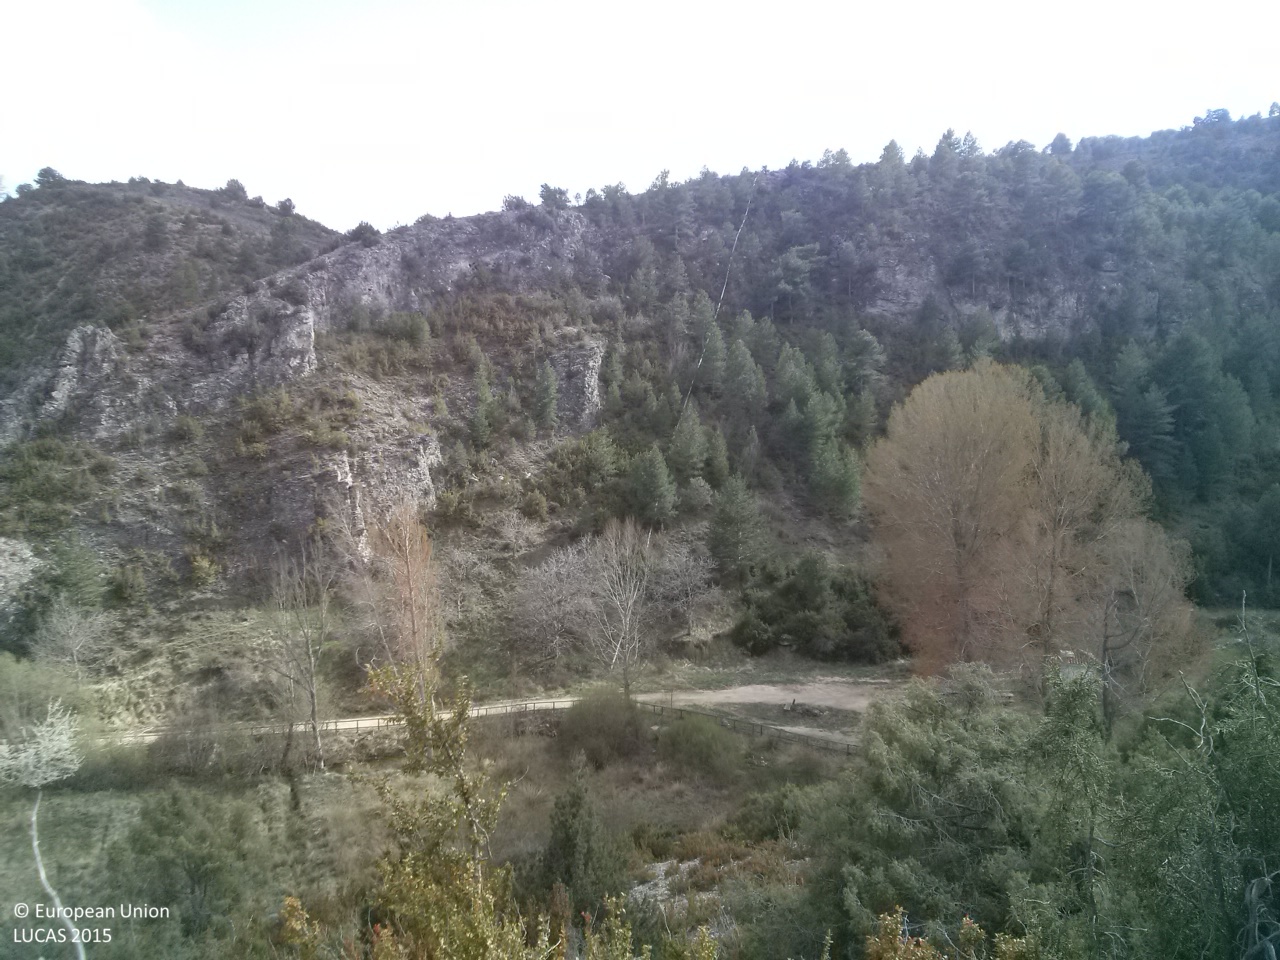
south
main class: Shrubland
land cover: Shrubland with sparse tree cover
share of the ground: 25 - 50 %
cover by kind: consolidated bare surface 50 %, shrubs 35 %, herbaceous plants 10 %, coniferous forest trees 5 %
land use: Agriculture (excluding fallow land and kitchen gardens)
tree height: < 5 m
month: April
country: ES
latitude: 40.1499
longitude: -1.6932
